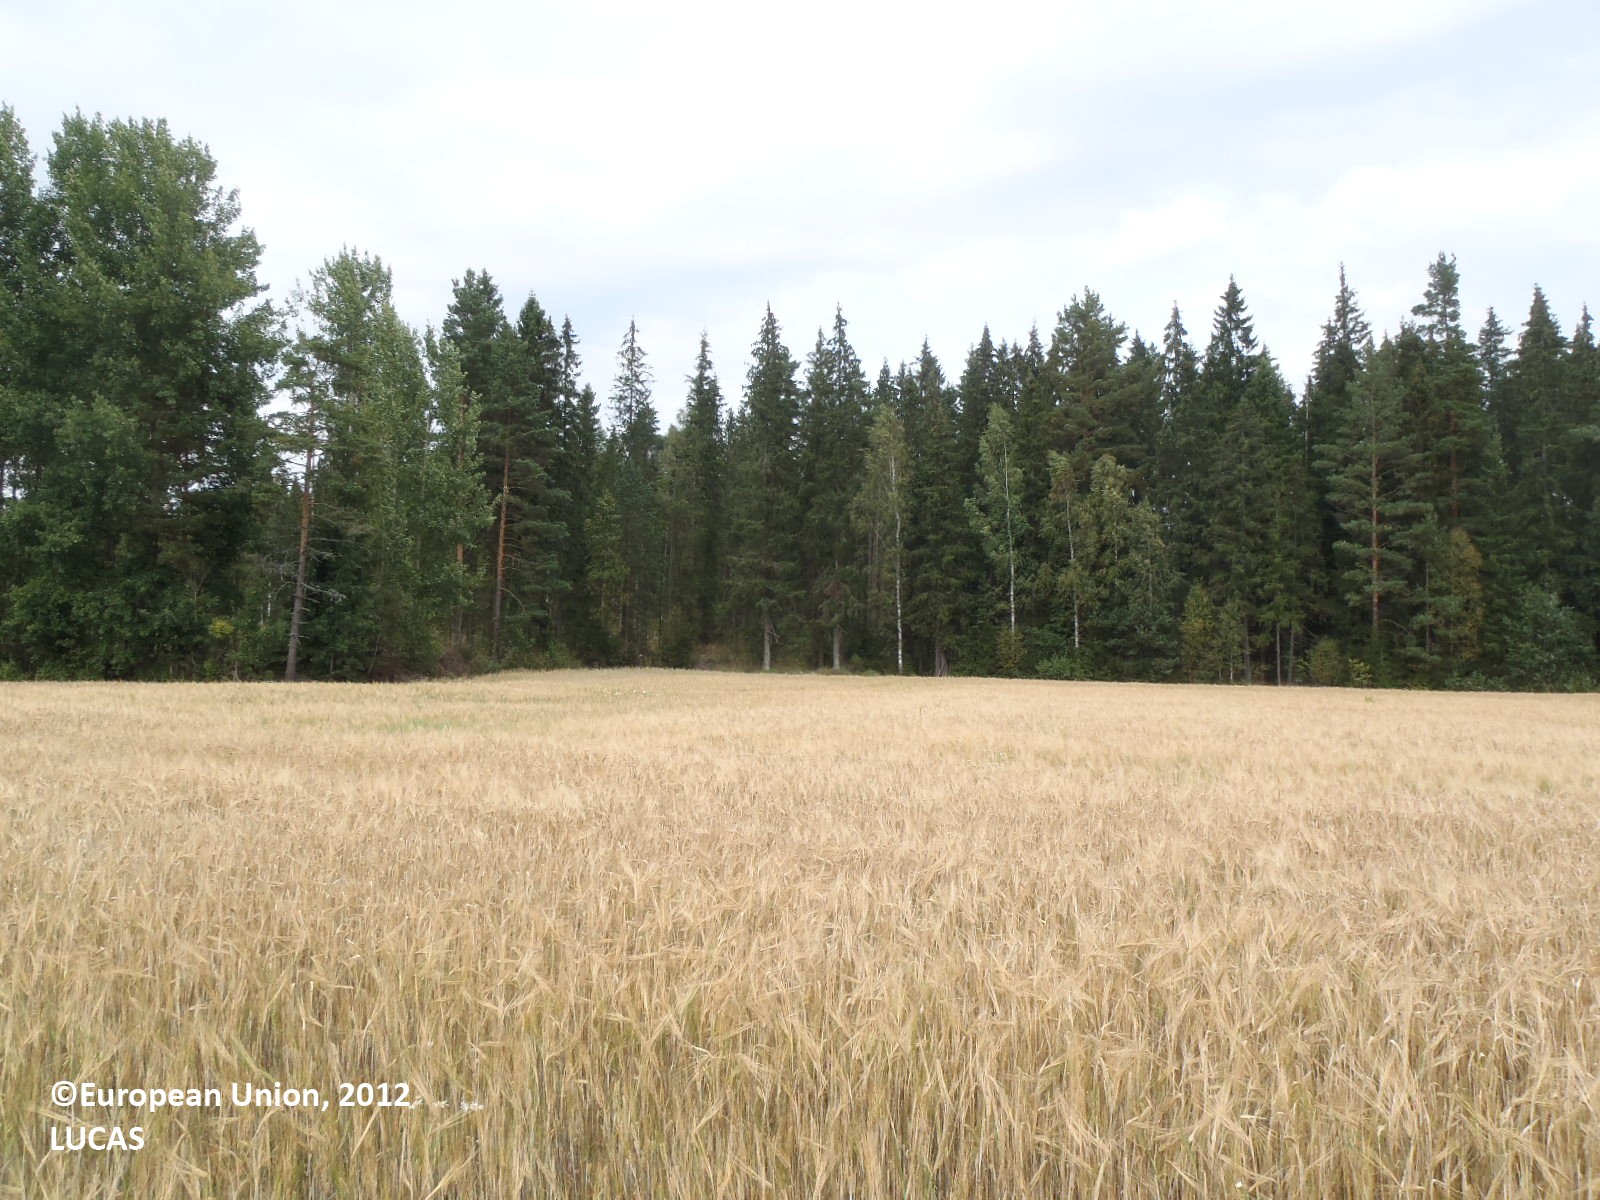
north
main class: Cropland
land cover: Barley
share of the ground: > 75 %
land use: Agriculture (excluding fallow land and kitchen gardens)
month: August
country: FI
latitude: 60.9944
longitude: 22.4717
